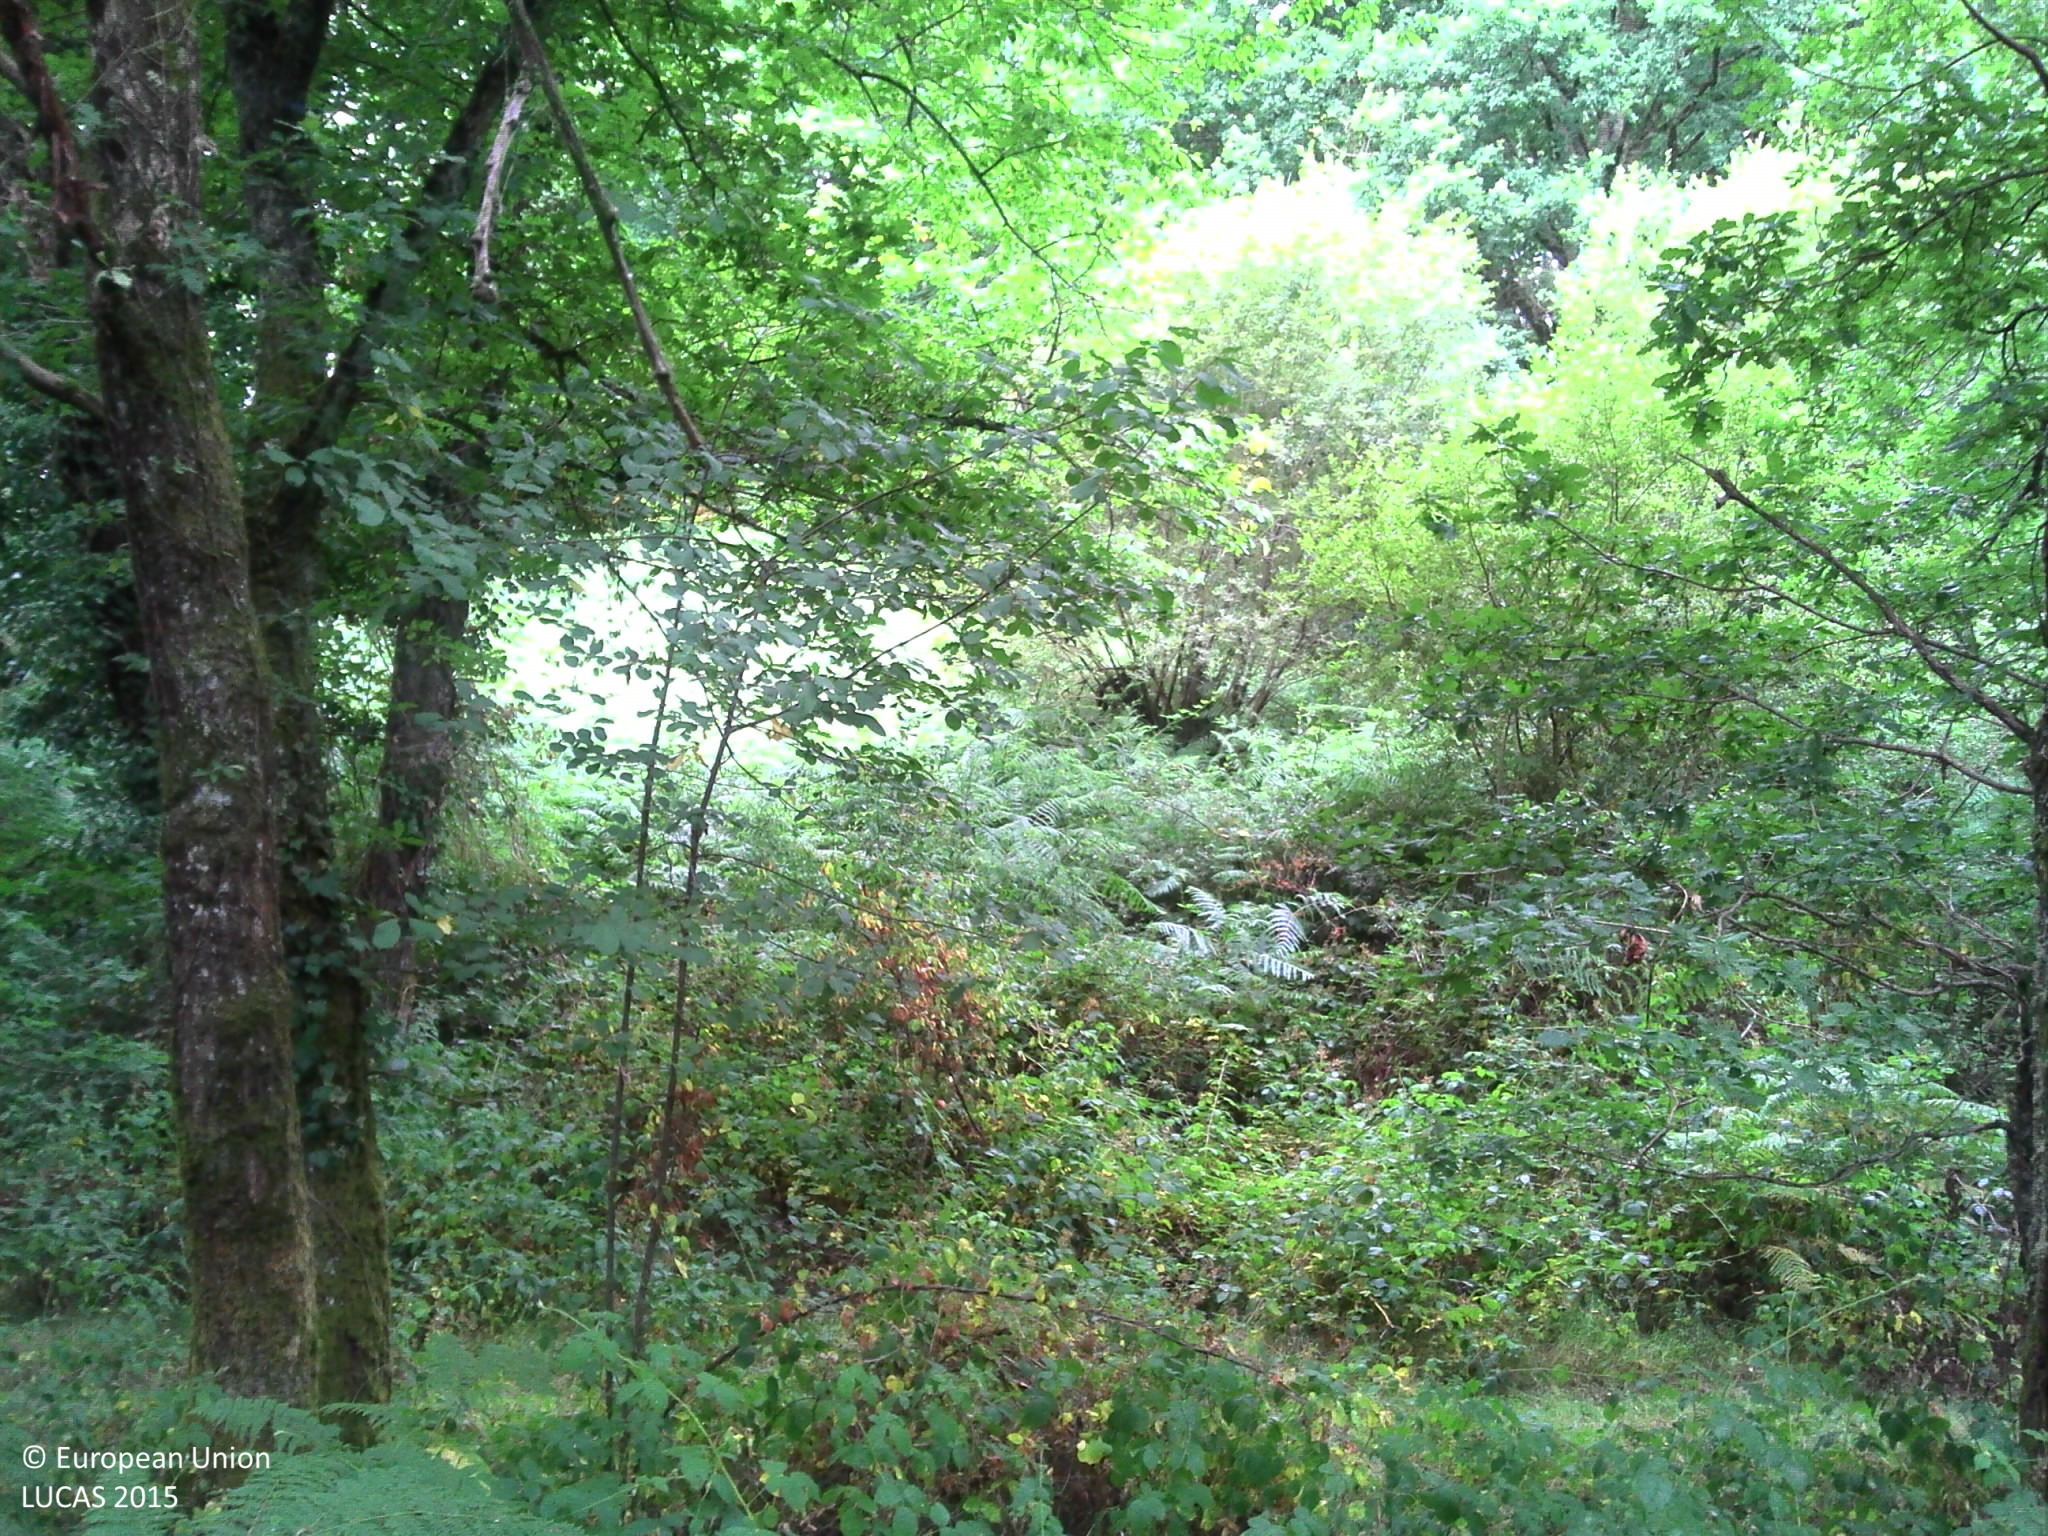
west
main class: Woodland
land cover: Broadleaved woodland
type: mesophytic deciduous forest
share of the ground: > 75 %
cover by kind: broadleaved forest trees 85 %, herbaceous plants 10 %, shrubs 5 %
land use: Forestry
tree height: > 5 m
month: July
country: FR
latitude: 46.4006
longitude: 1.6014
